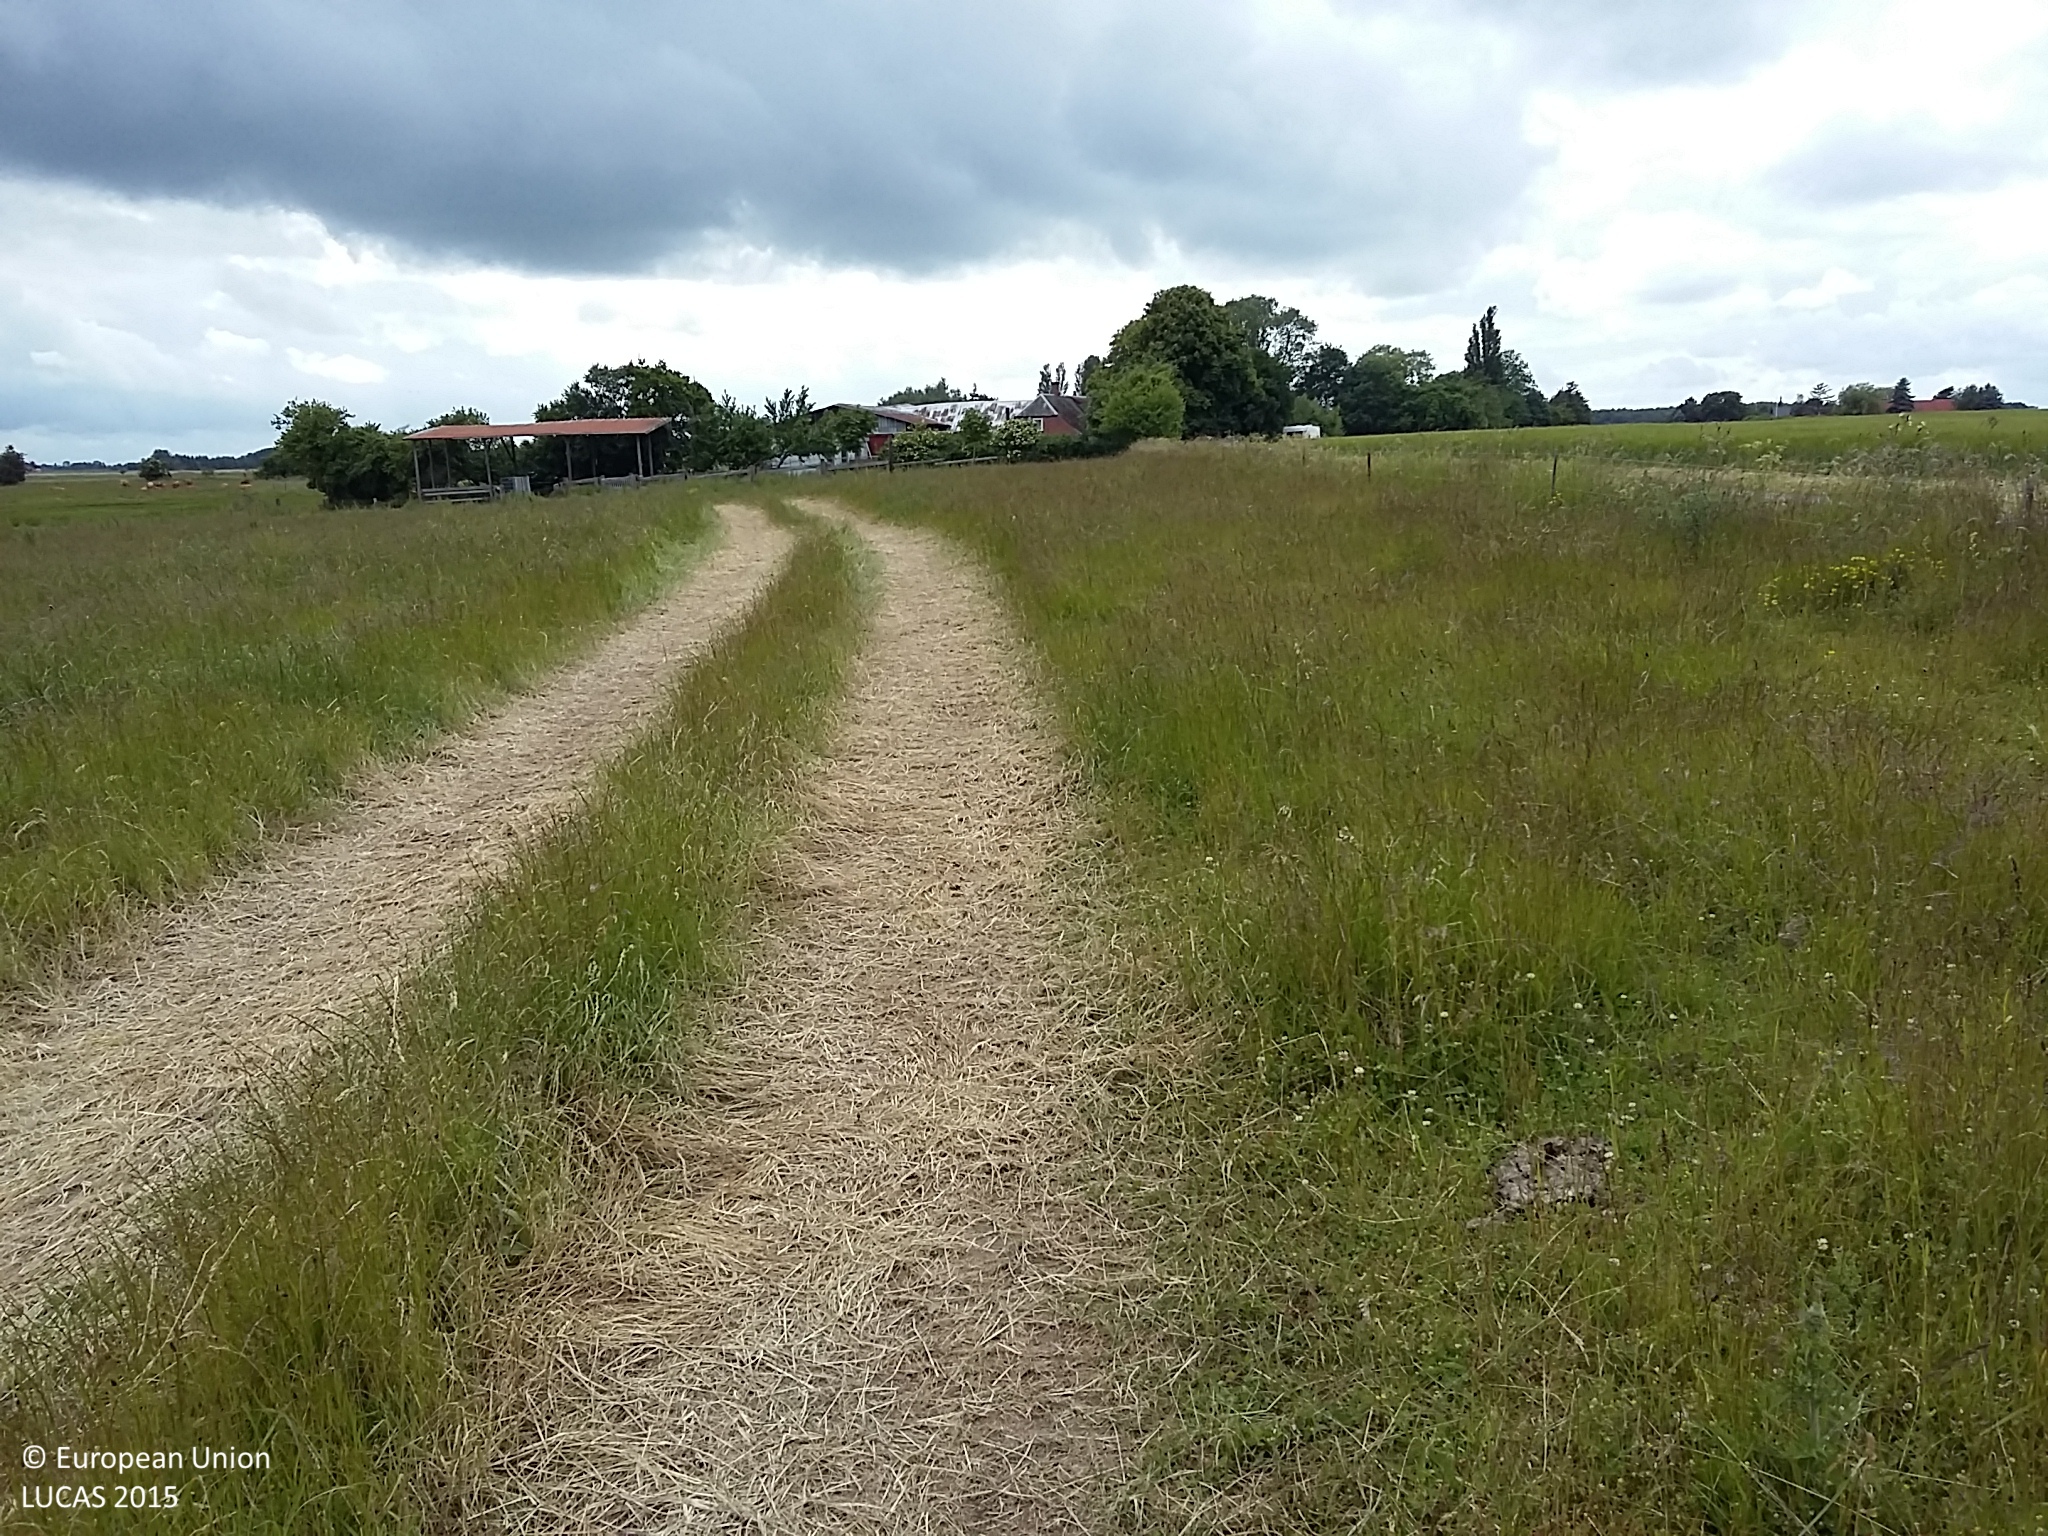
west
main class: Grassland
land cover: Grassland without tree/shrub cover
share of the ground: > 75 %
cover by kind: herbaceous plants 100 %
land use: Agriculture (excluding fallow land and kitchen gardens)
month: June
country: DK
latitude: 54.6677
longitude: 11.5960
